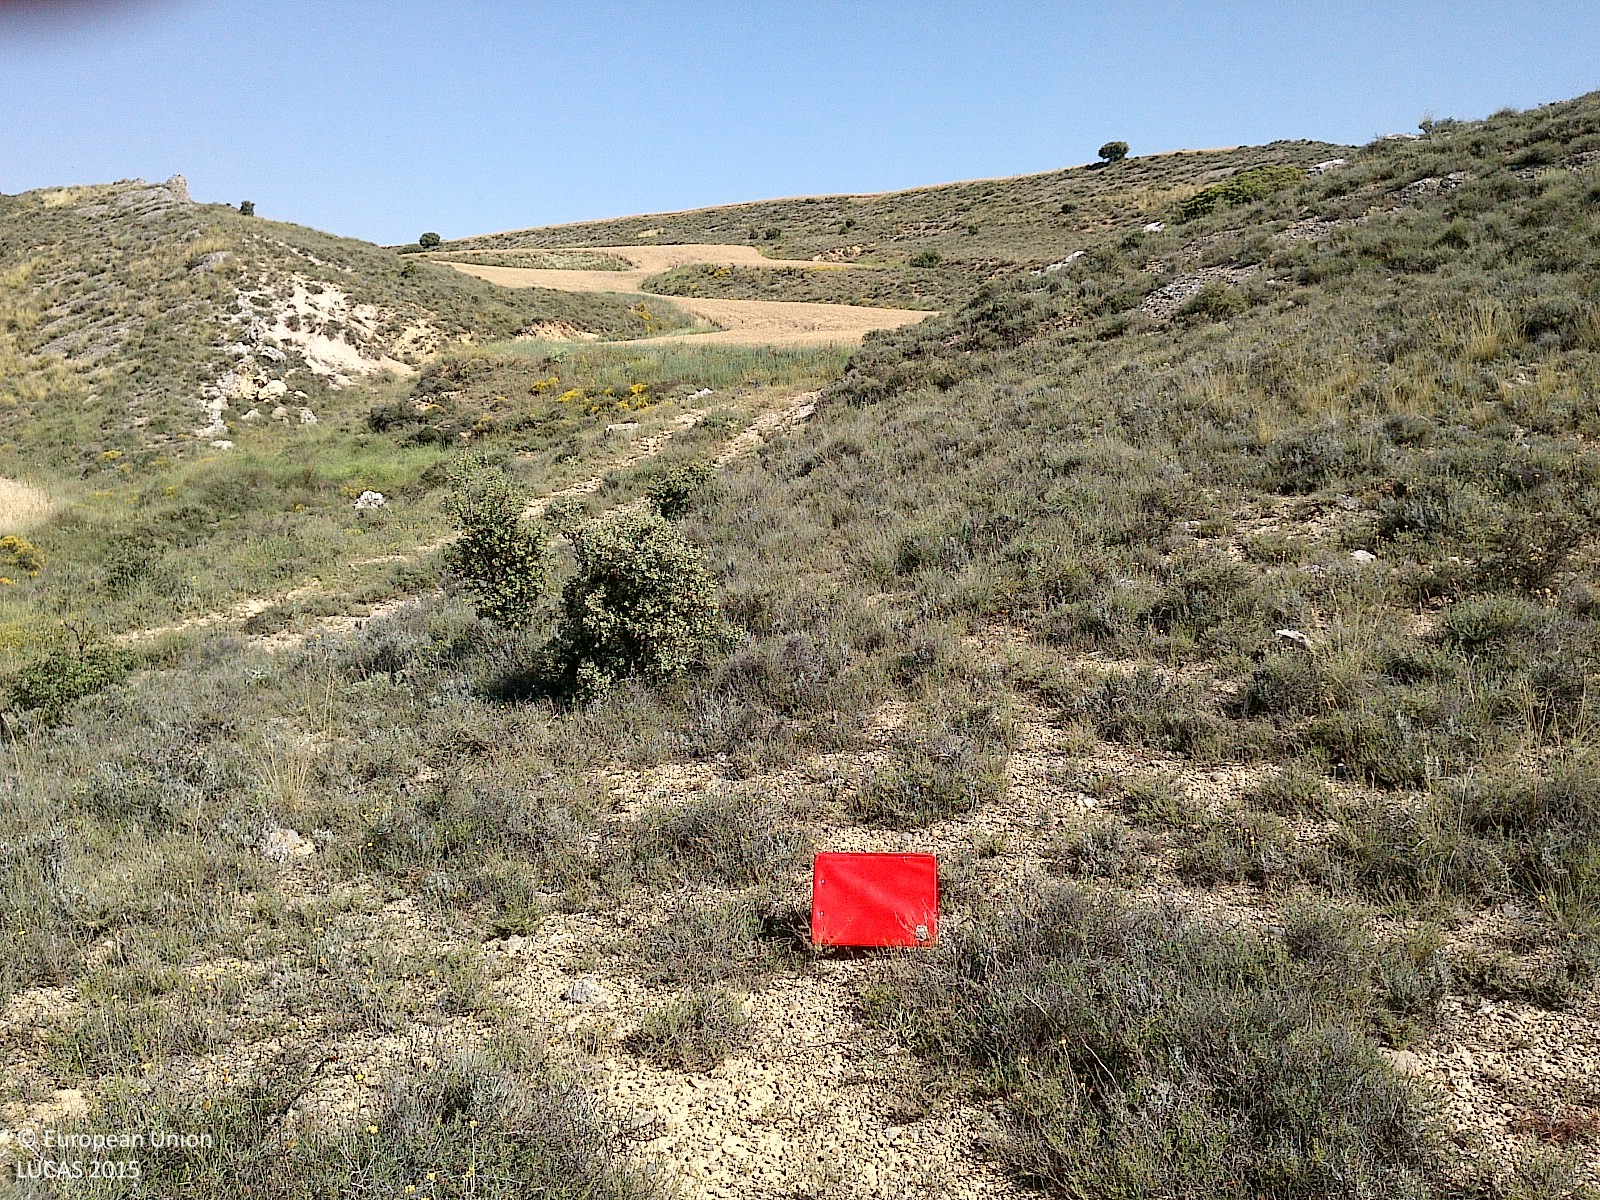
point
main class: Shrubland
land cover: Shrubland without tree cover
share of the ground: > 75 %
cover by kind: shrubs 75 %, unconsolidated bare surface 20 %, consolidated bare surface 5 %
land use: Semi-natural and natural areas not in use
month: July
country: ES
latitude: 41.5365
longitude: -2.1502
